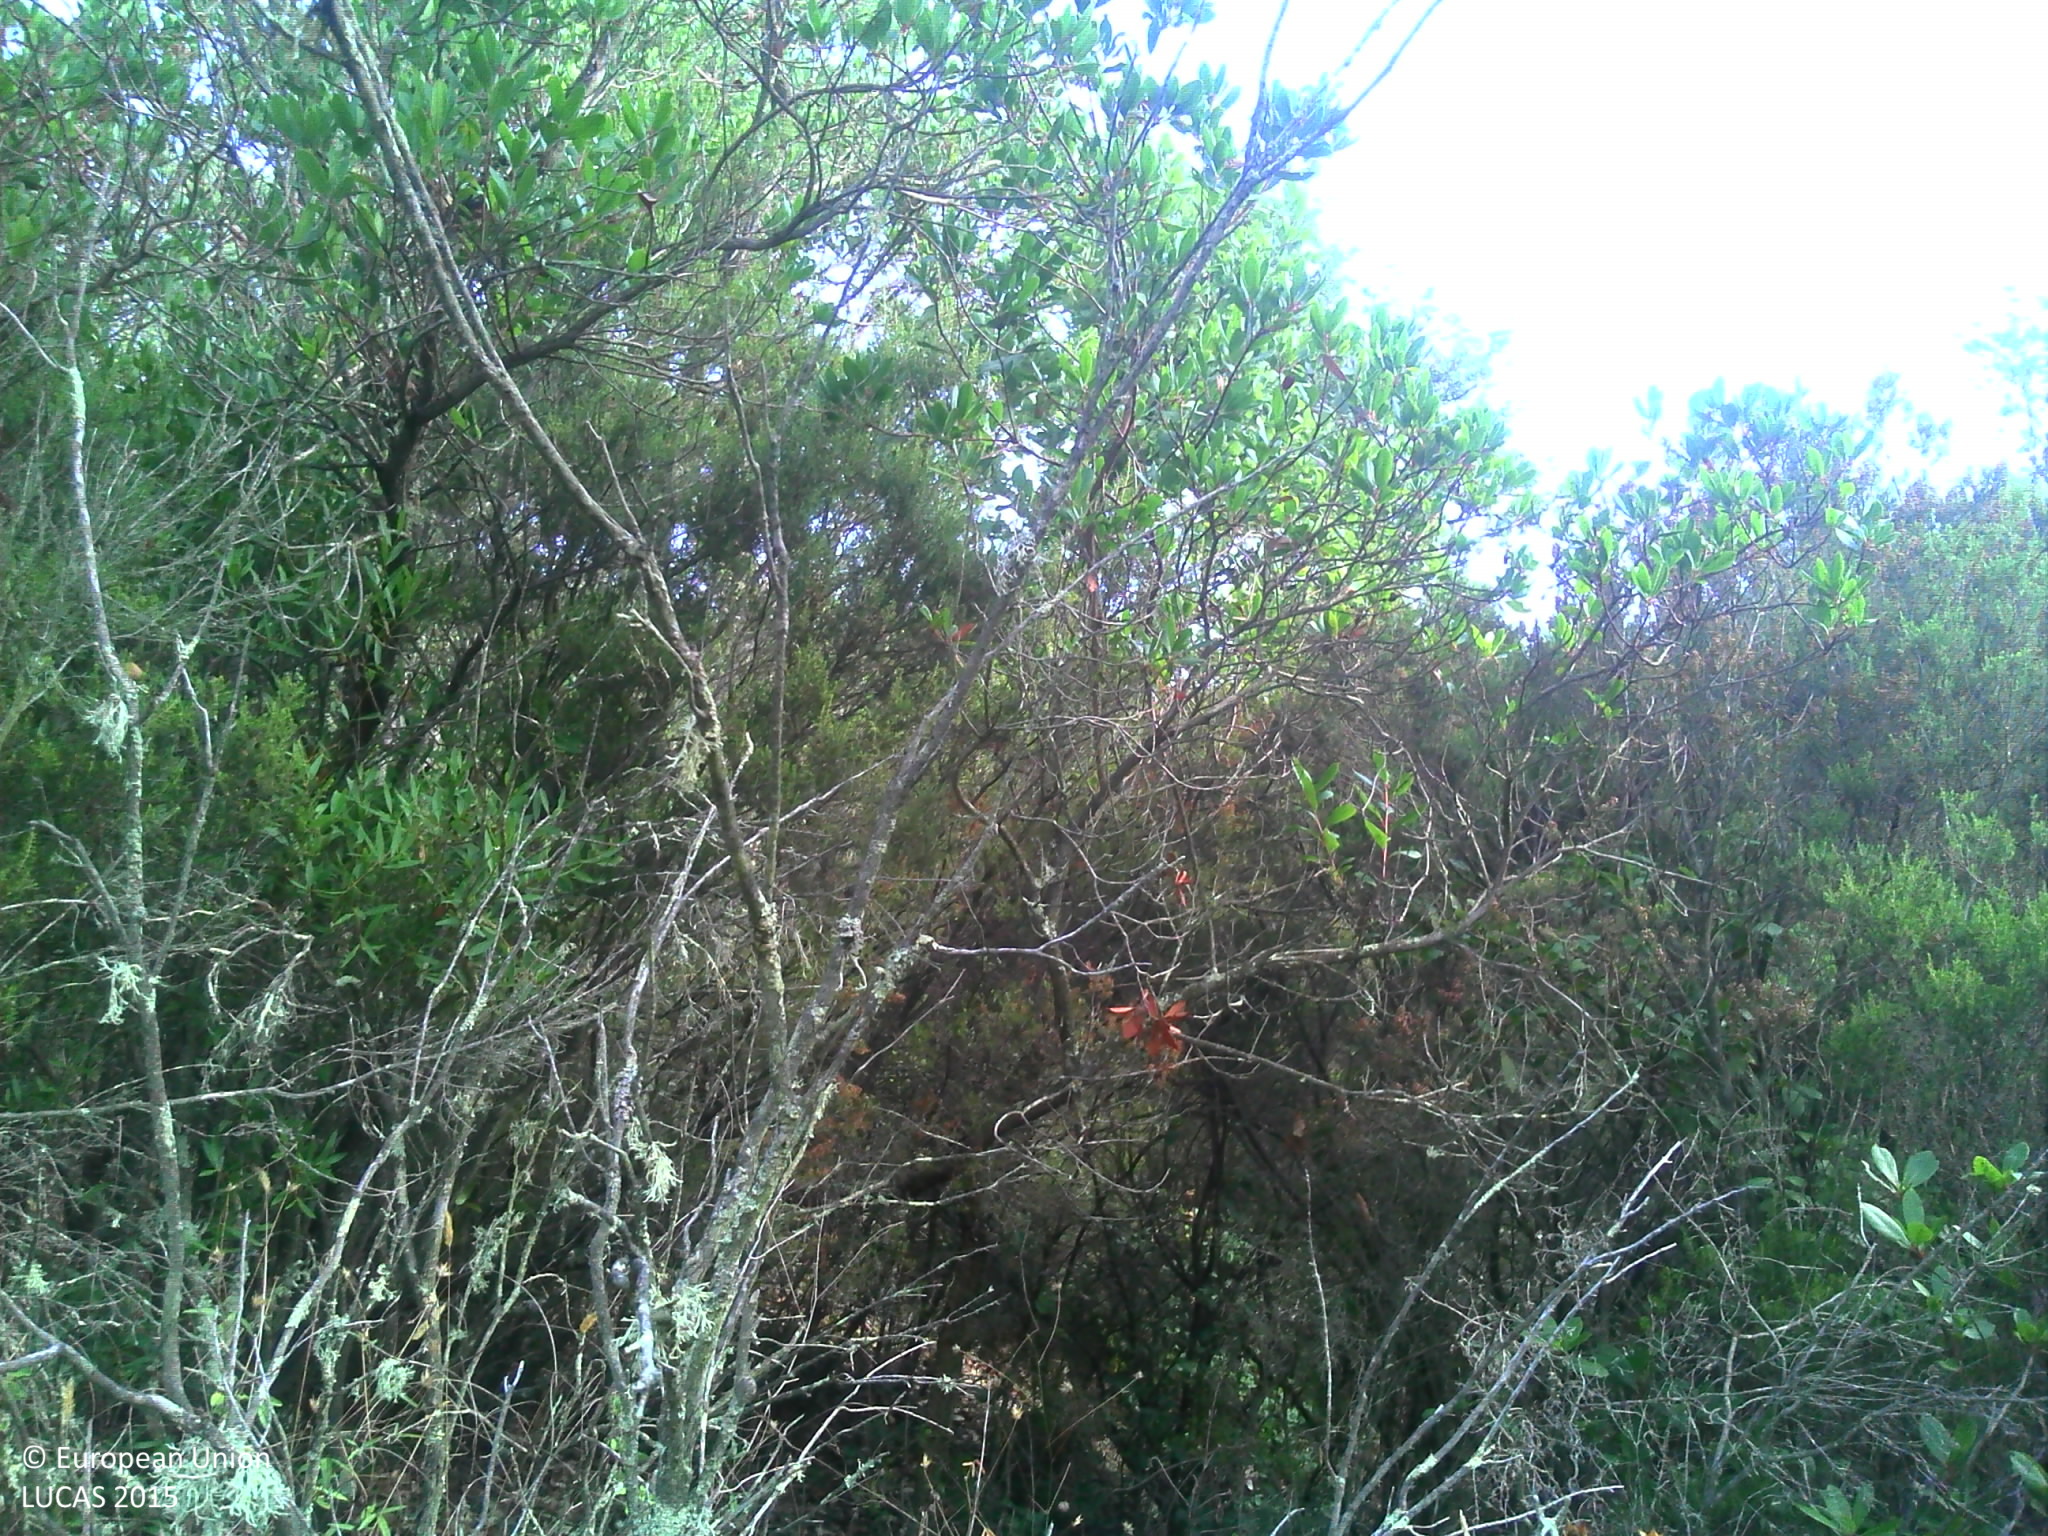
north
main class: Shrubland
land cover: Shrubland with sparse tree cover
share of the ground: > 75 %
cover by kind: shrubs 90 %, broadleaved forest trees 5 %, unconsolidated bare surface 5 %
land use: Semi-natural and natural areas not in use
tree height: < 5 m
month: July
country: FR
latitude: 43.1849
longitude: 6.3553
